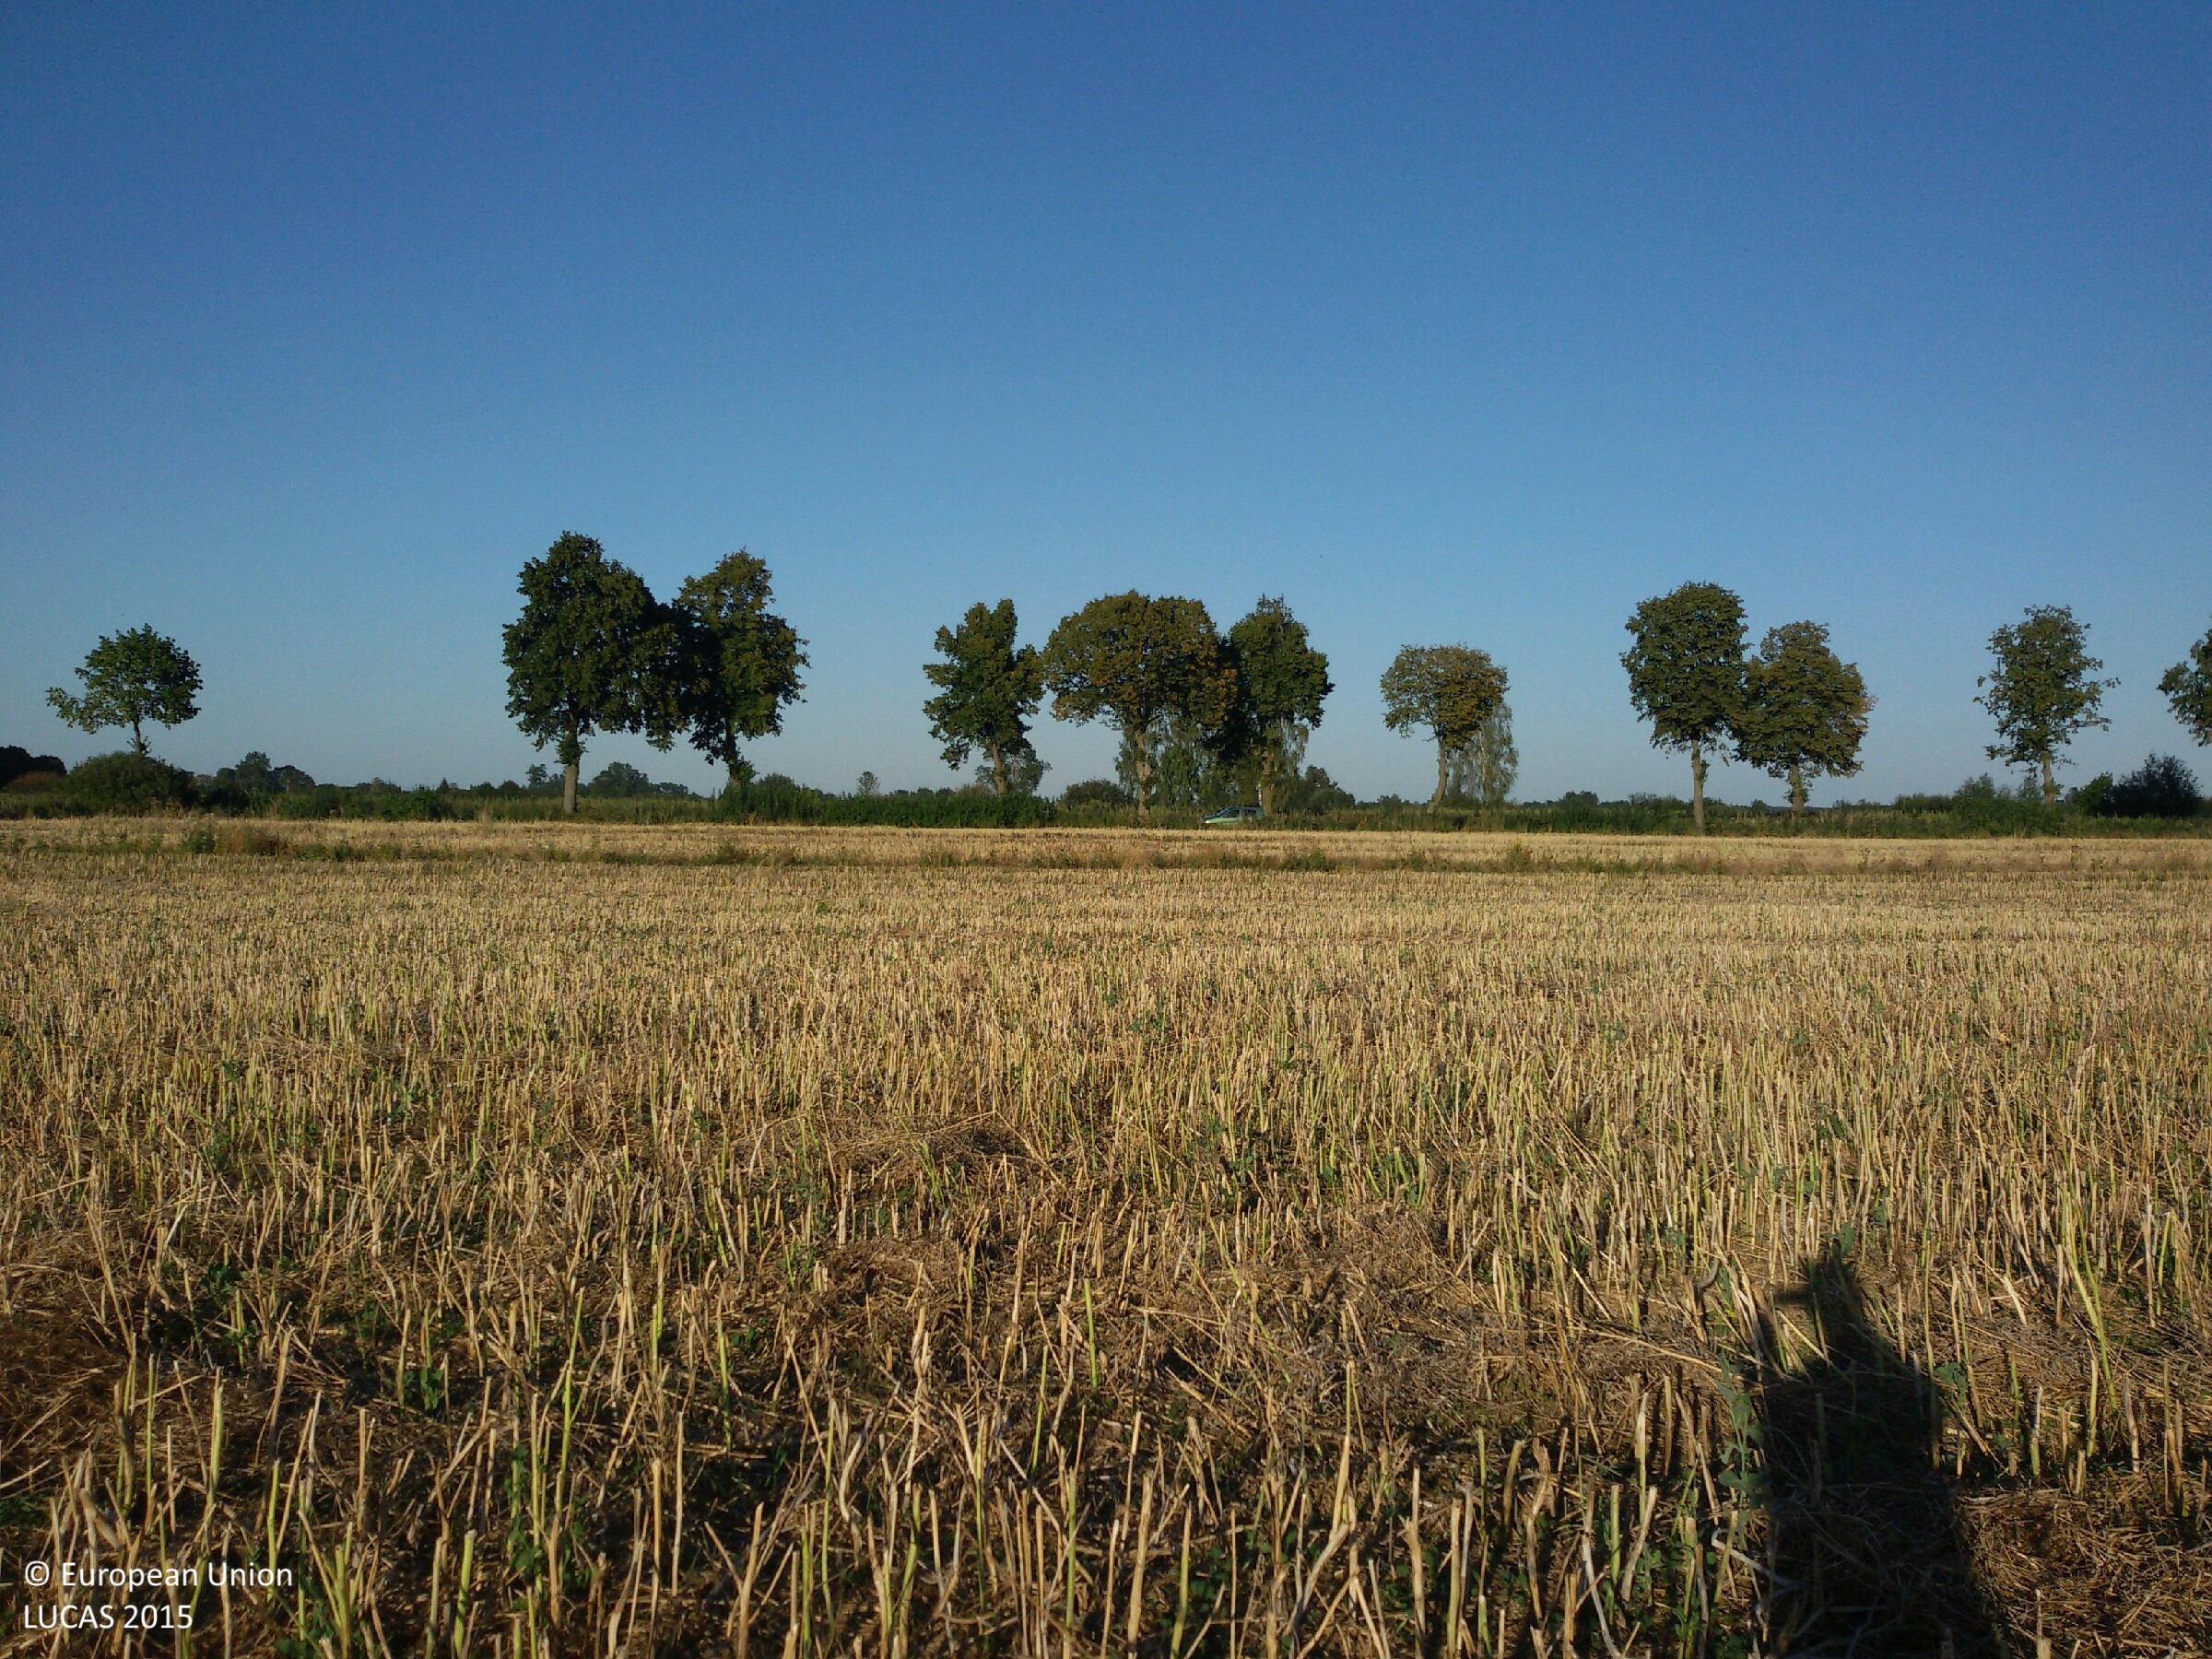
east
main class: Cropland
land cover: Rape and turnip rape
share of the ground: 50 - 75 %
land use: Agriculture (excluding fallow land and kitchen gardens)
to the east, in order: Rape and turnip rape; Grass margins; Rape and turnip rape; Grass margins; Ditches and canals; Lines of trees; Paved roads, cycling and walking lanes; Lines of trees; Ditches and canals; Grass margins; Spontaneously vegetated surfaces; Ditches and canals; Arable land (only in case pi)
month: August
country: PL
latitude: 54.0527
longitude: 19.3576
